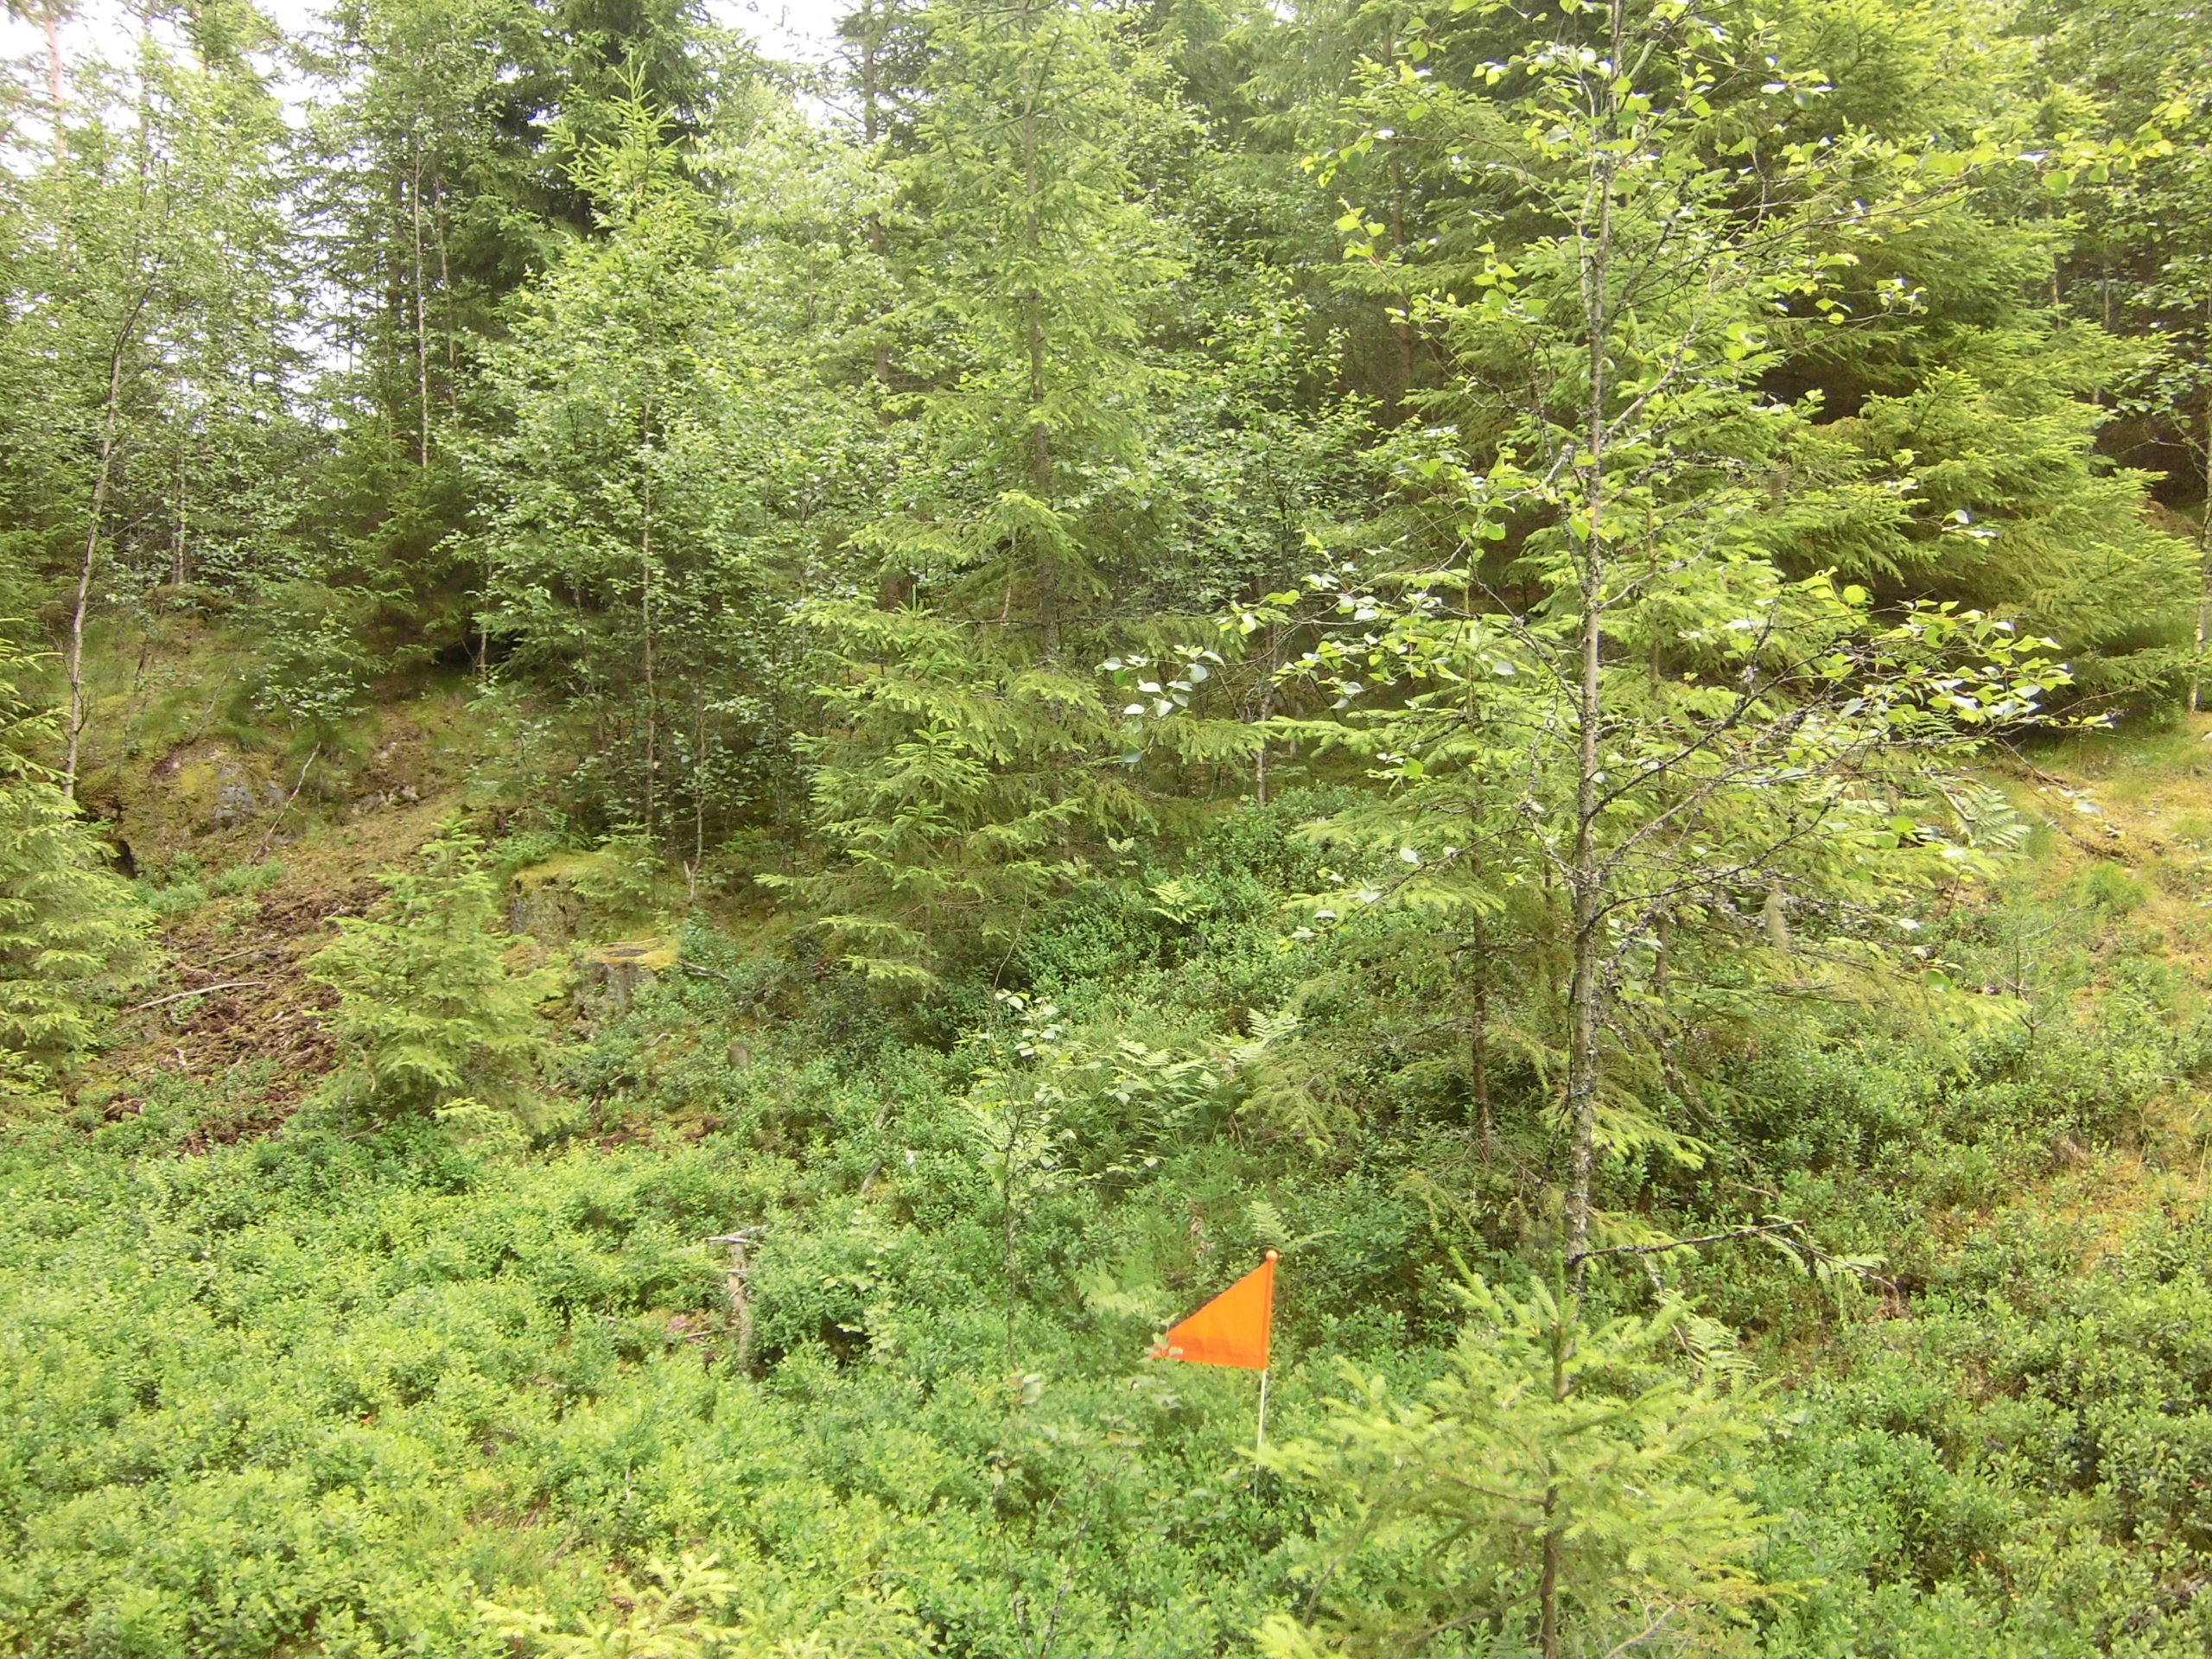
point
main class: Woodland
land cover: Spruce dominated mixed woodland
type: boreal forest
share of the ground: 50 - 75 %
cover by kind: coniferous forest trees 30 %, shrubs 25 %, broadleaved forest trees 20 %, lichens and mosses 15 %, herbaceous plants 10 %
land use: Forestry
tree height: > 5 m
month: July
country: SE
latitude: 57.2723
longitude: 15.1876
